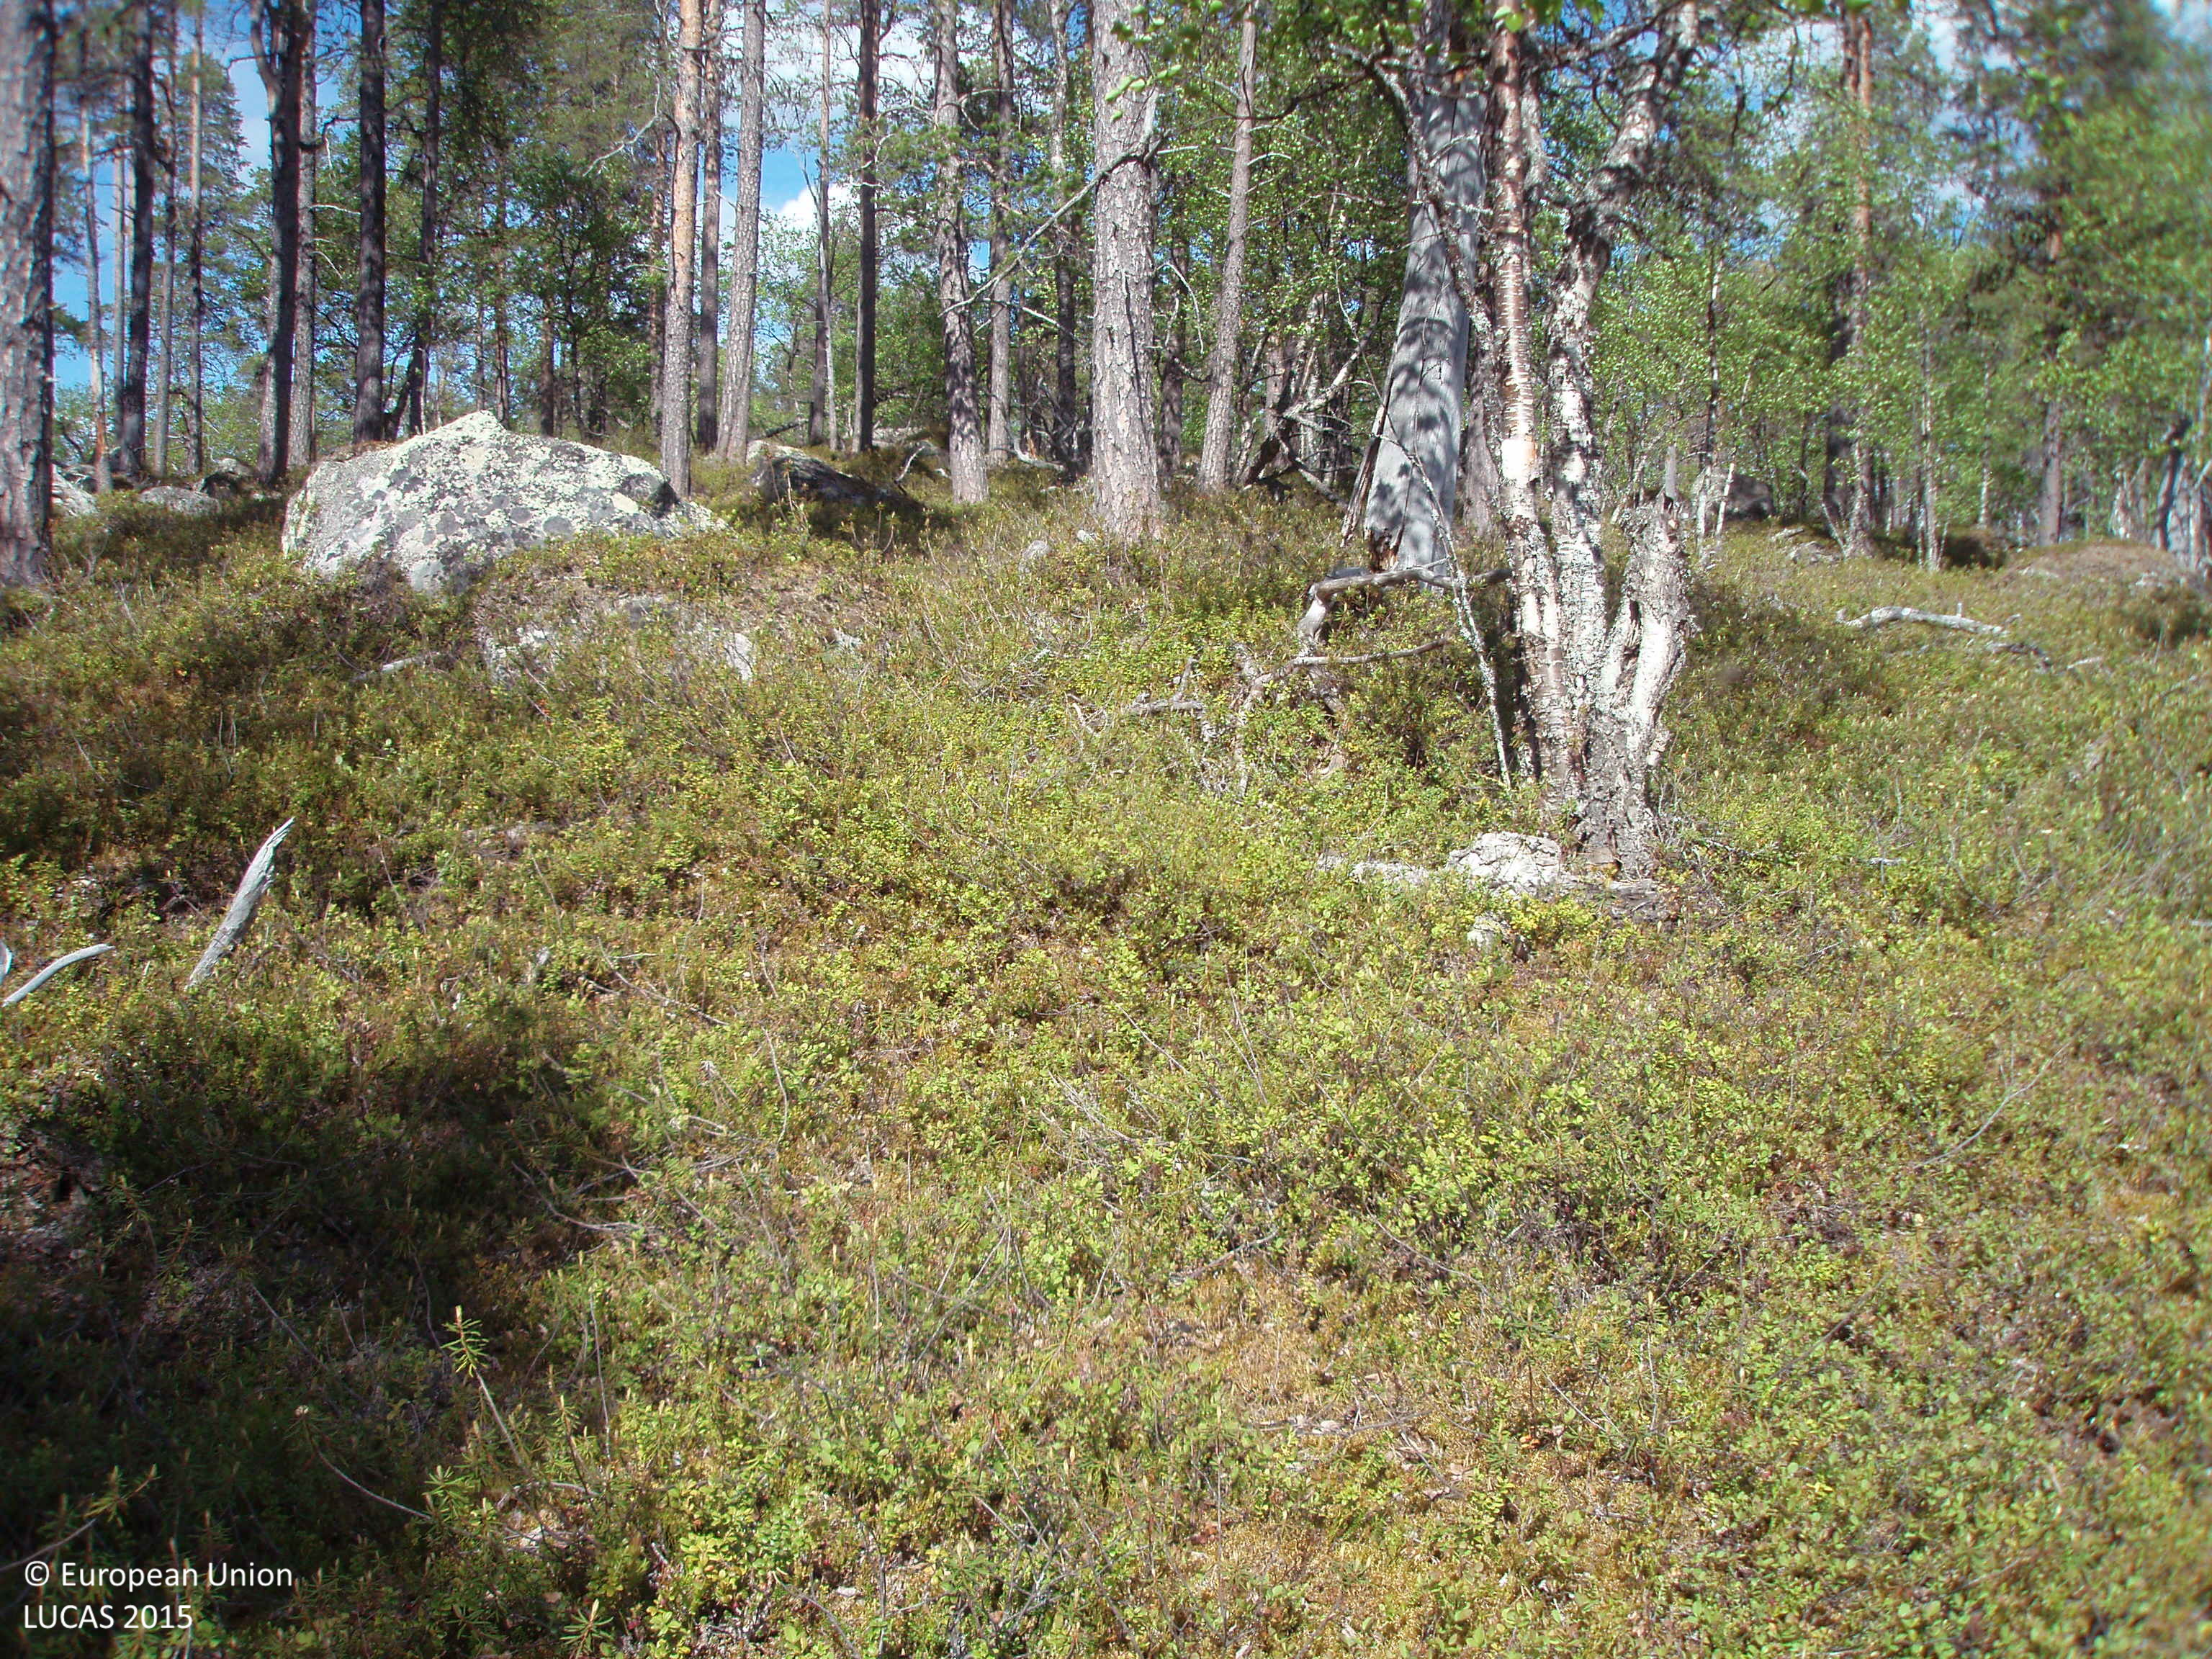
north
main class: Woodland
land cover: Pine dominated mixed woodland
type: boreal forest
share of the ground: 50 - 75 %
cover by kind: coniferous forest trees 35 %, broadleaved forest trees 35 %, shrubs 30 %
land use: Forestry
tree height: > 5 m
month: June
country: FI
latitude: 68.7486
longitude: 28.1151
